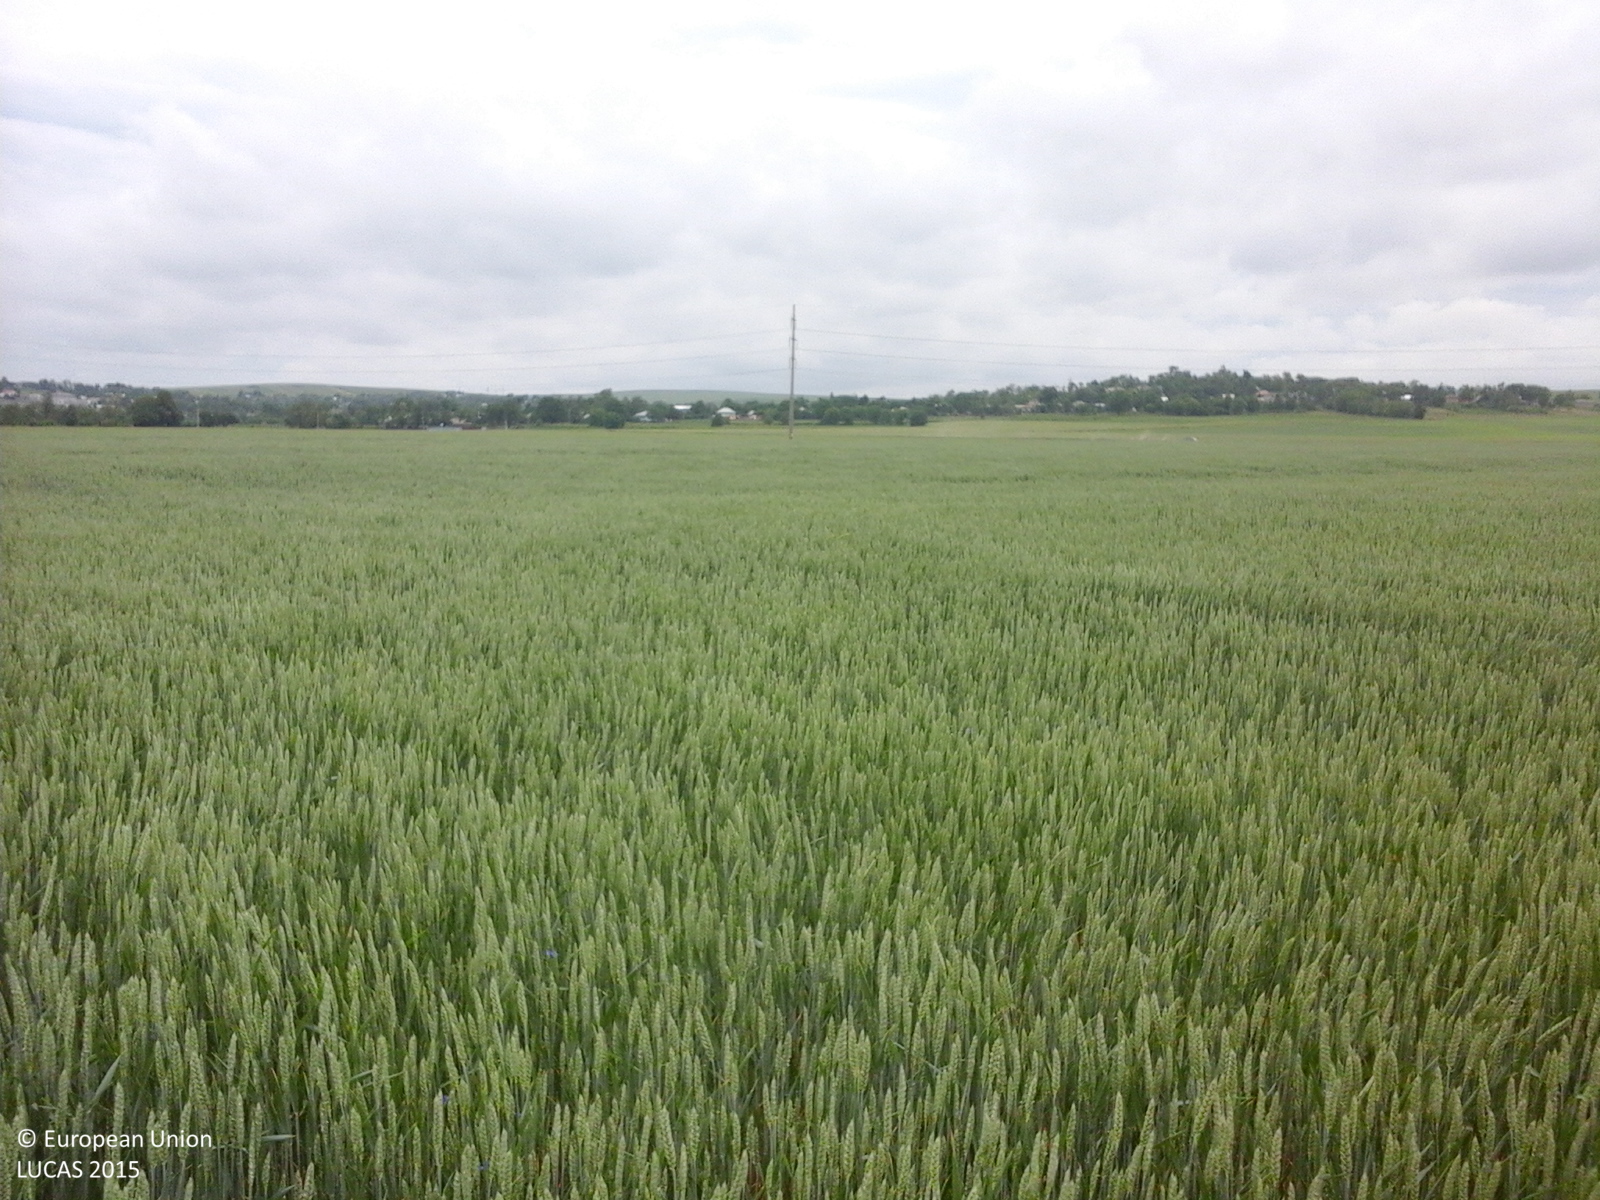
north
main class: Cropland
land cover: Common wheat
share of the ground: > 75 %
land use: Agriculture (excluding fallow land and kitchen gardens)
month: June
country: RO
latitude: 47.1233
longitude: 26.6870
